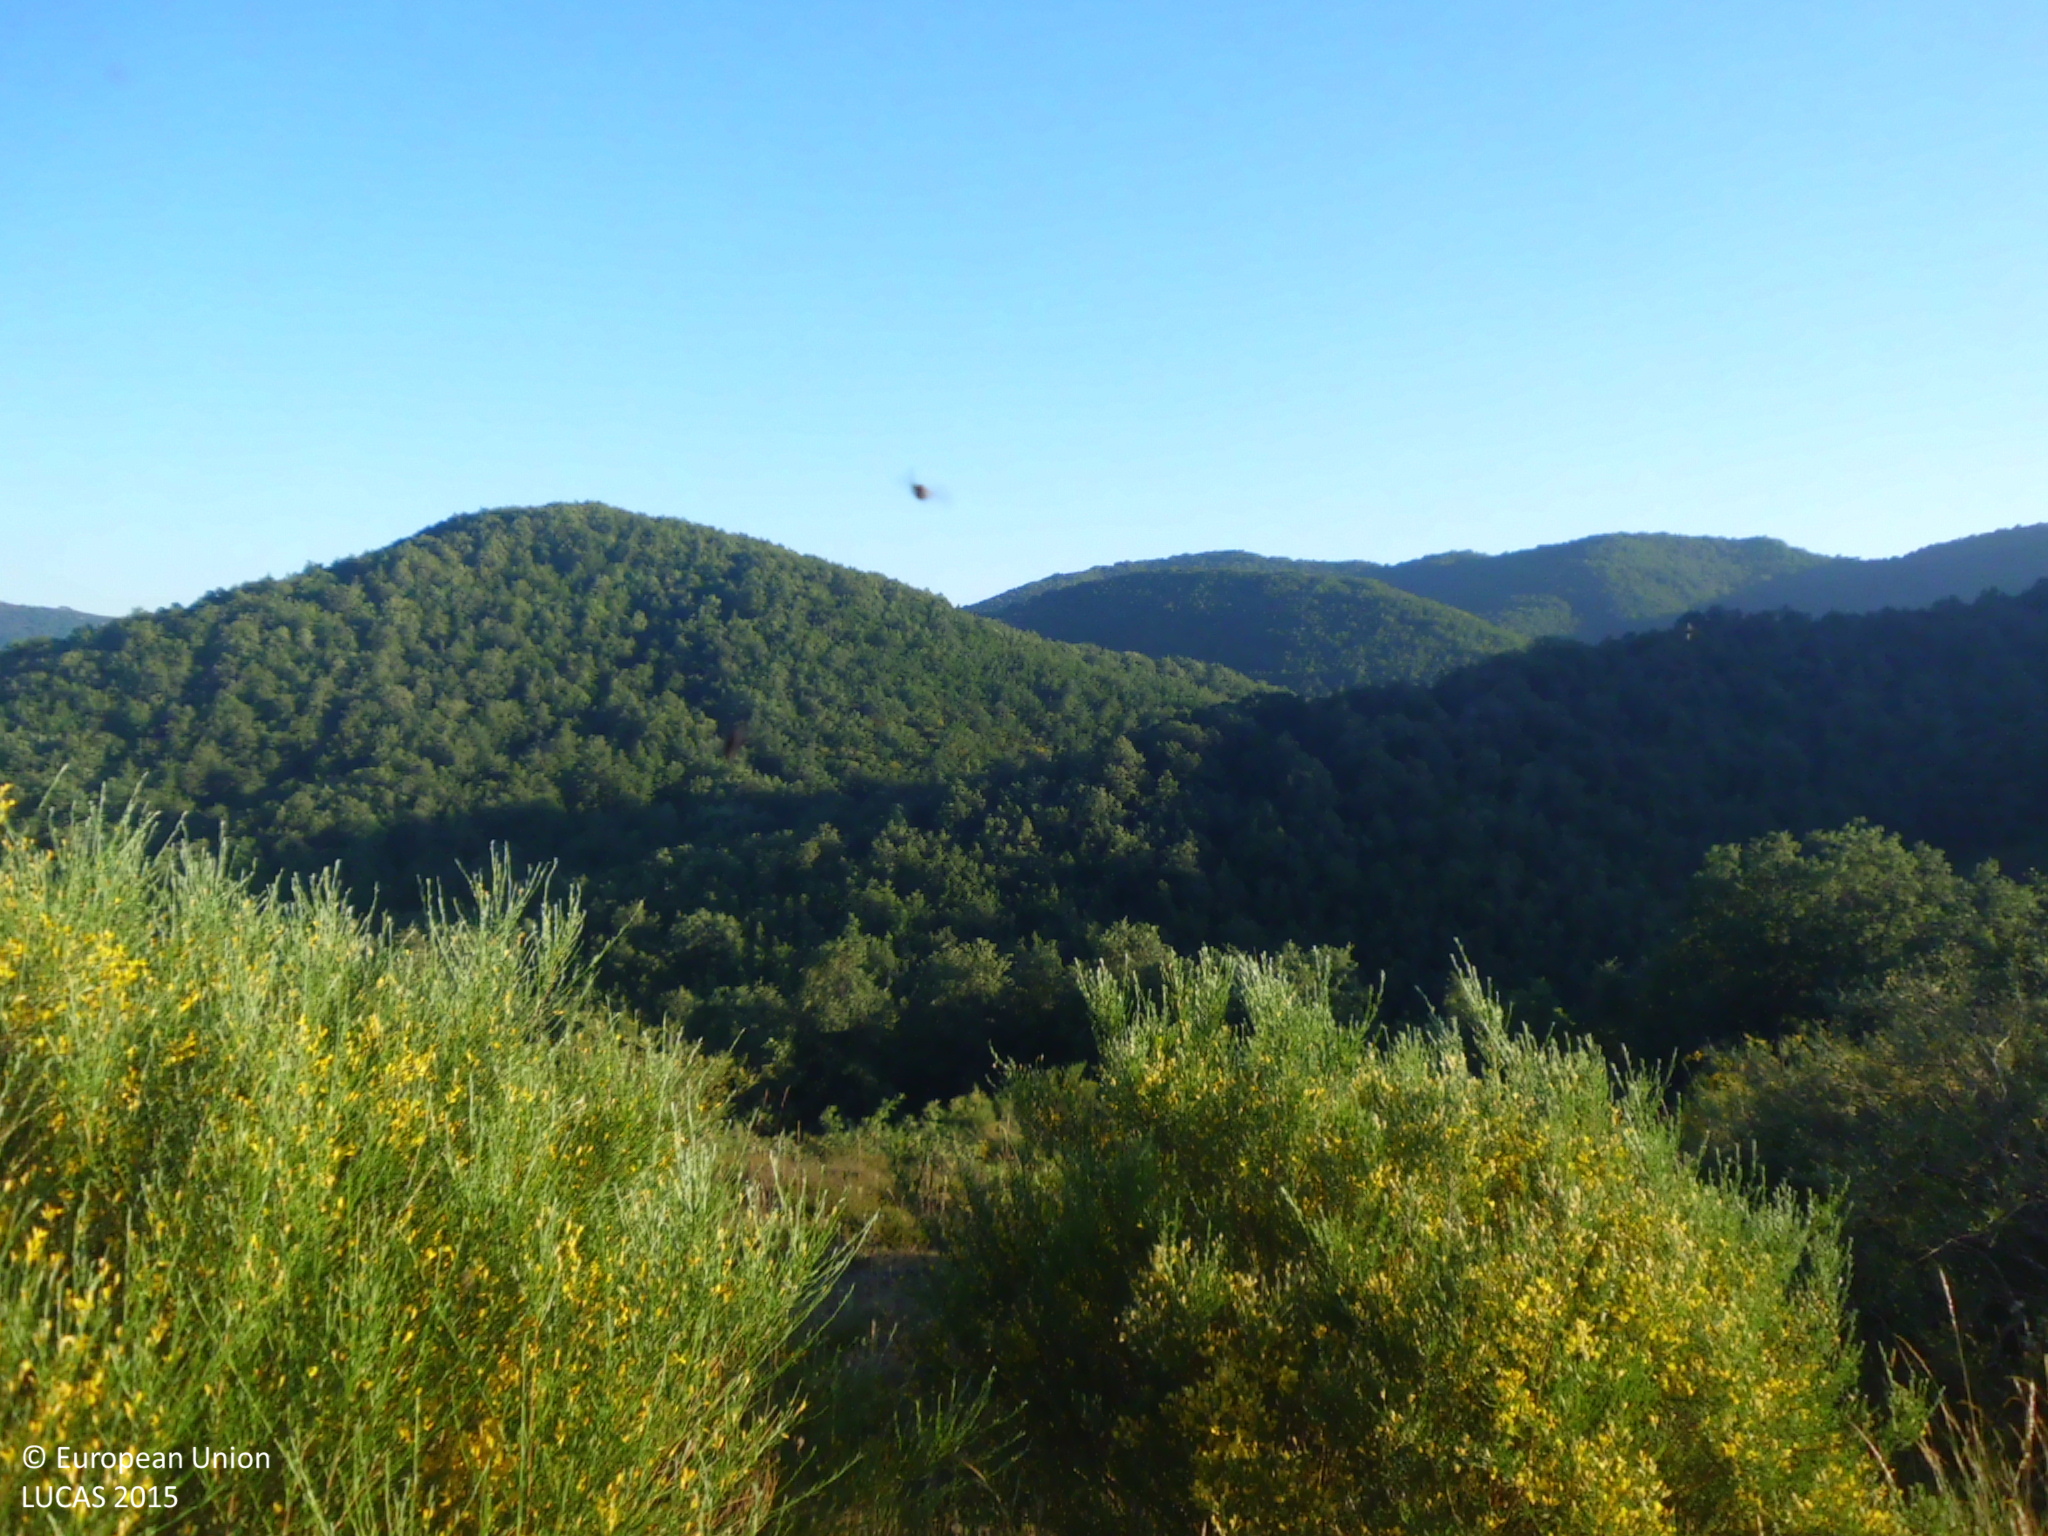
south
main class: Shrubland
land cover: Shrubland without tree cover
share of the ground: 25 - 50 %
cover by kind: shrubs 35 %, herbaceous plants 35 %, consolidated bare surface 30 %
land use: Agriculture (excluding fallow land and kitchen gardens)
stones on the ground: 10 - 25 %
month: June
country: ES
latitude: 42.9090
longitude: -4.9709
